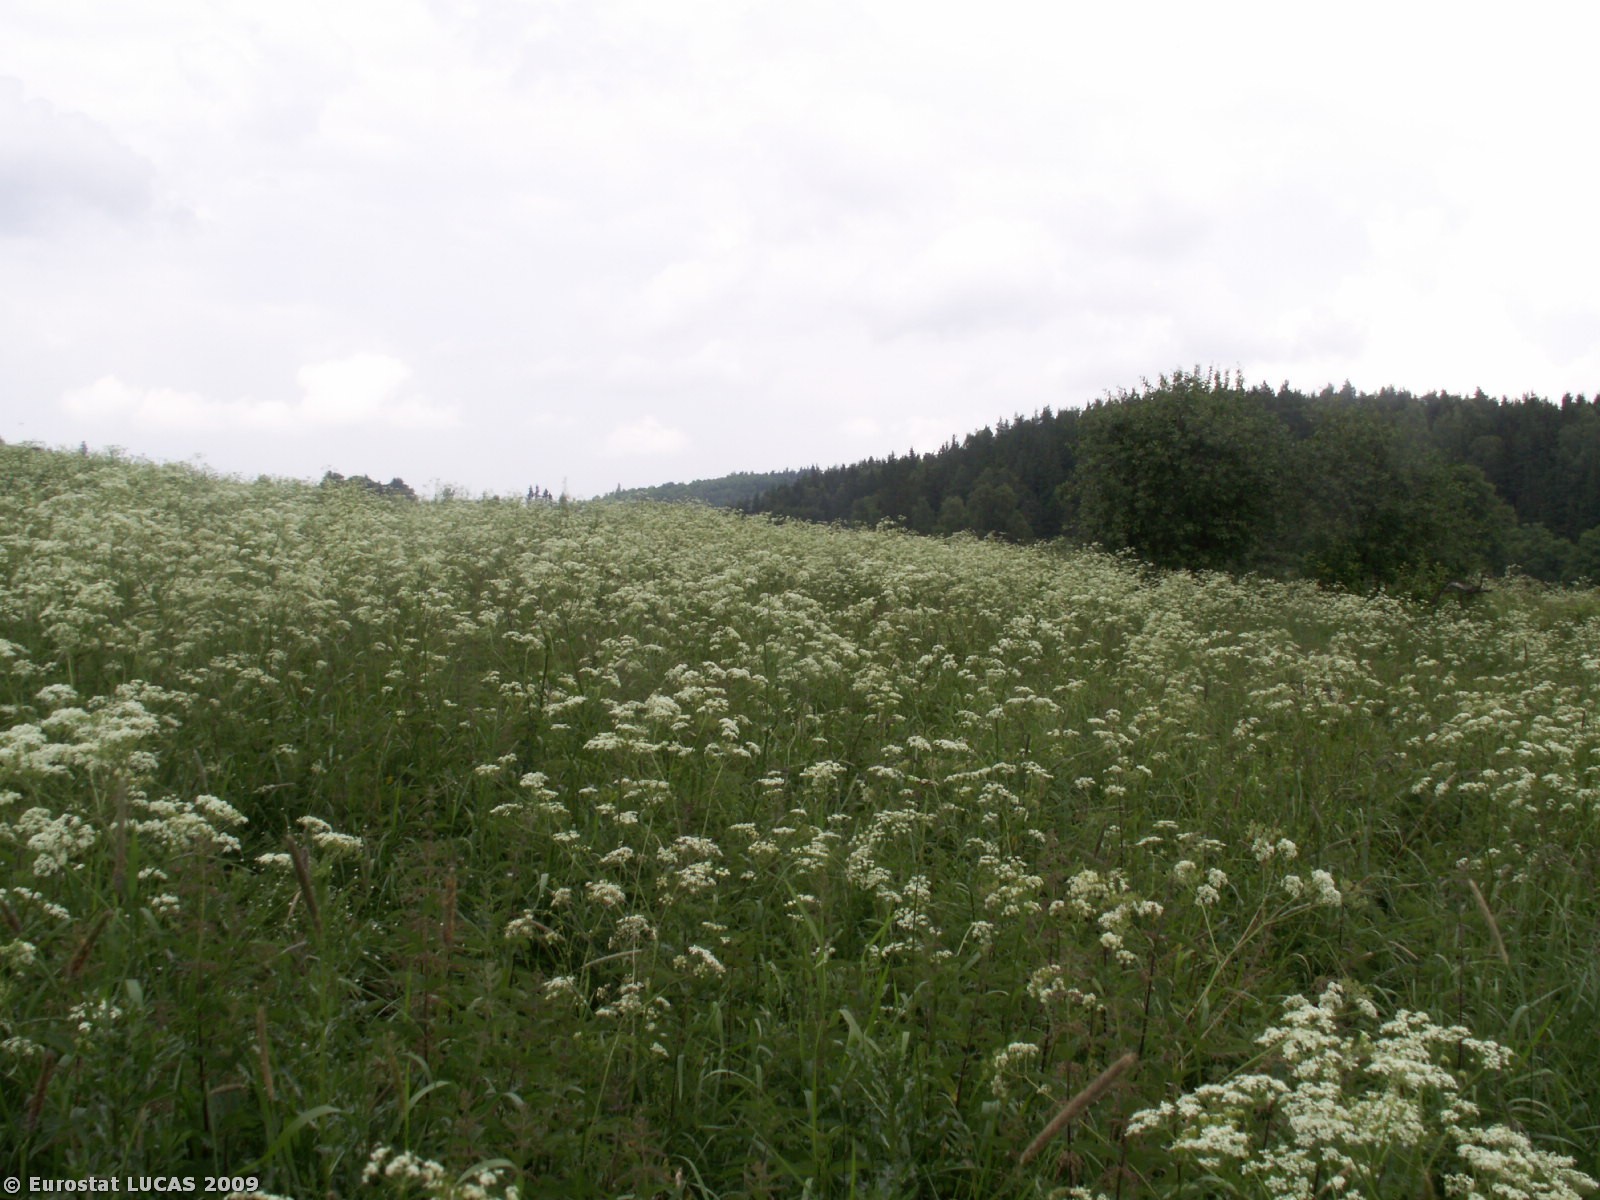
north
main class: Grassland
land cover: Spontaneously vegetated surfaces
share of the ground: > 75 %
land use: Fallow land
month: June
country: CZ
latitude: 50.1625
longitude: 13.0096
